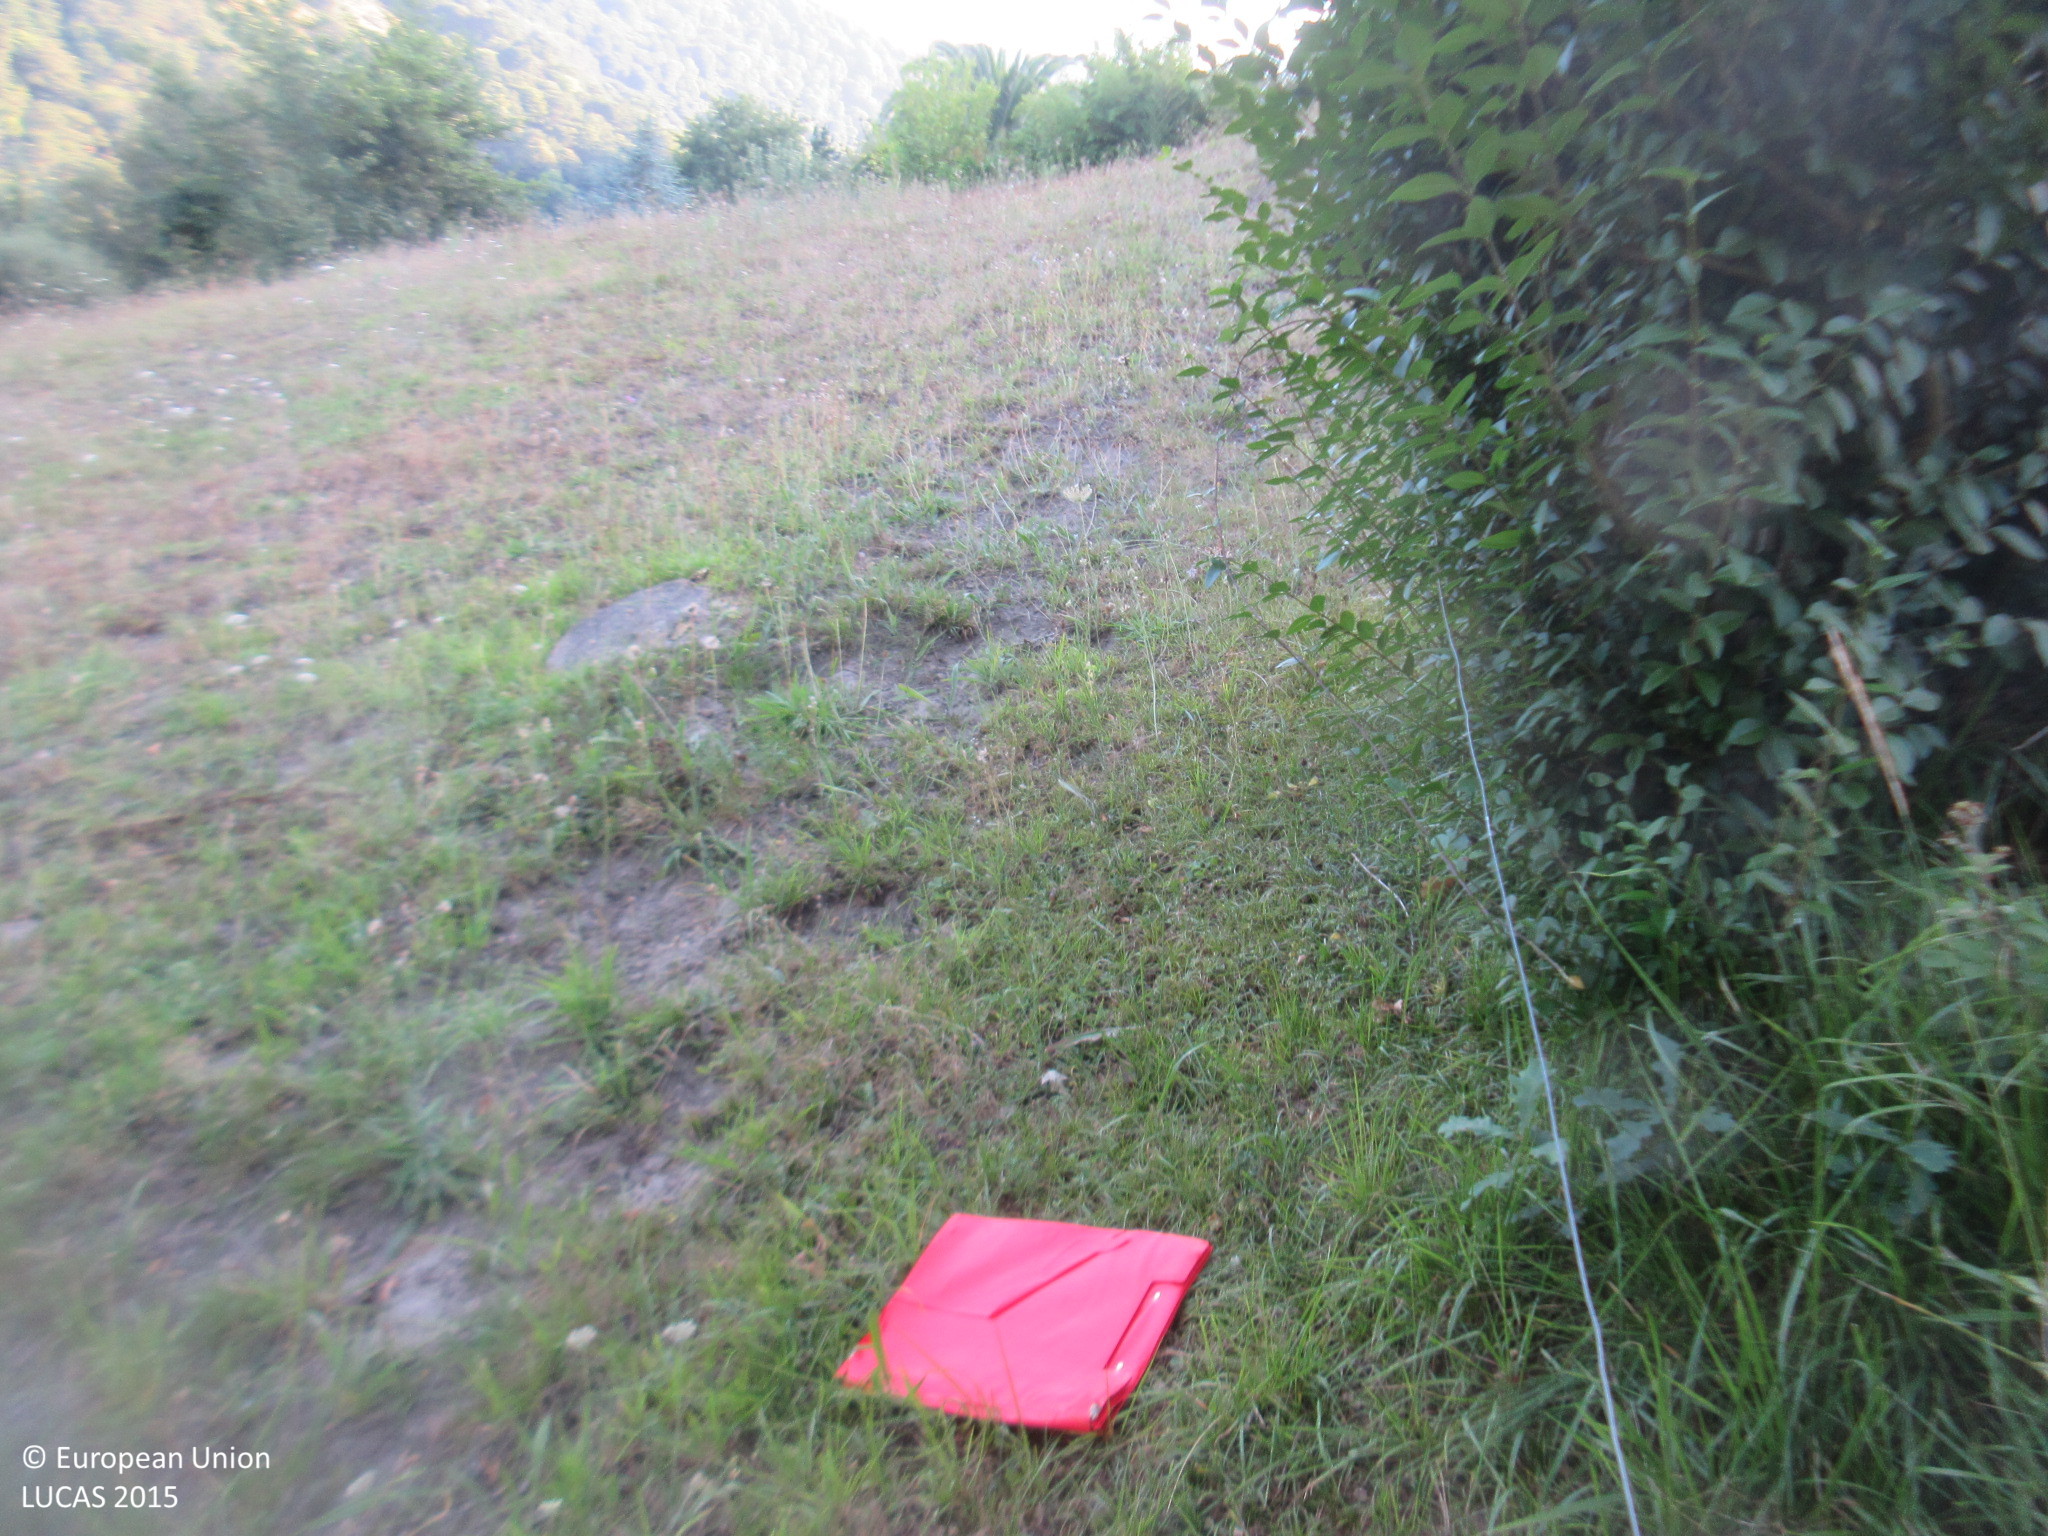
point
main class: Grassland
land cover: Grassland without tree/shrub cover
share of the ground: > 75 %
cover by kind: herbaceous plants 100 %
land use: Agriculture (excluding fallow land and kitchen gardens)
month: July
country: ES
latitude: 43.2380
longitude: -3.9523
